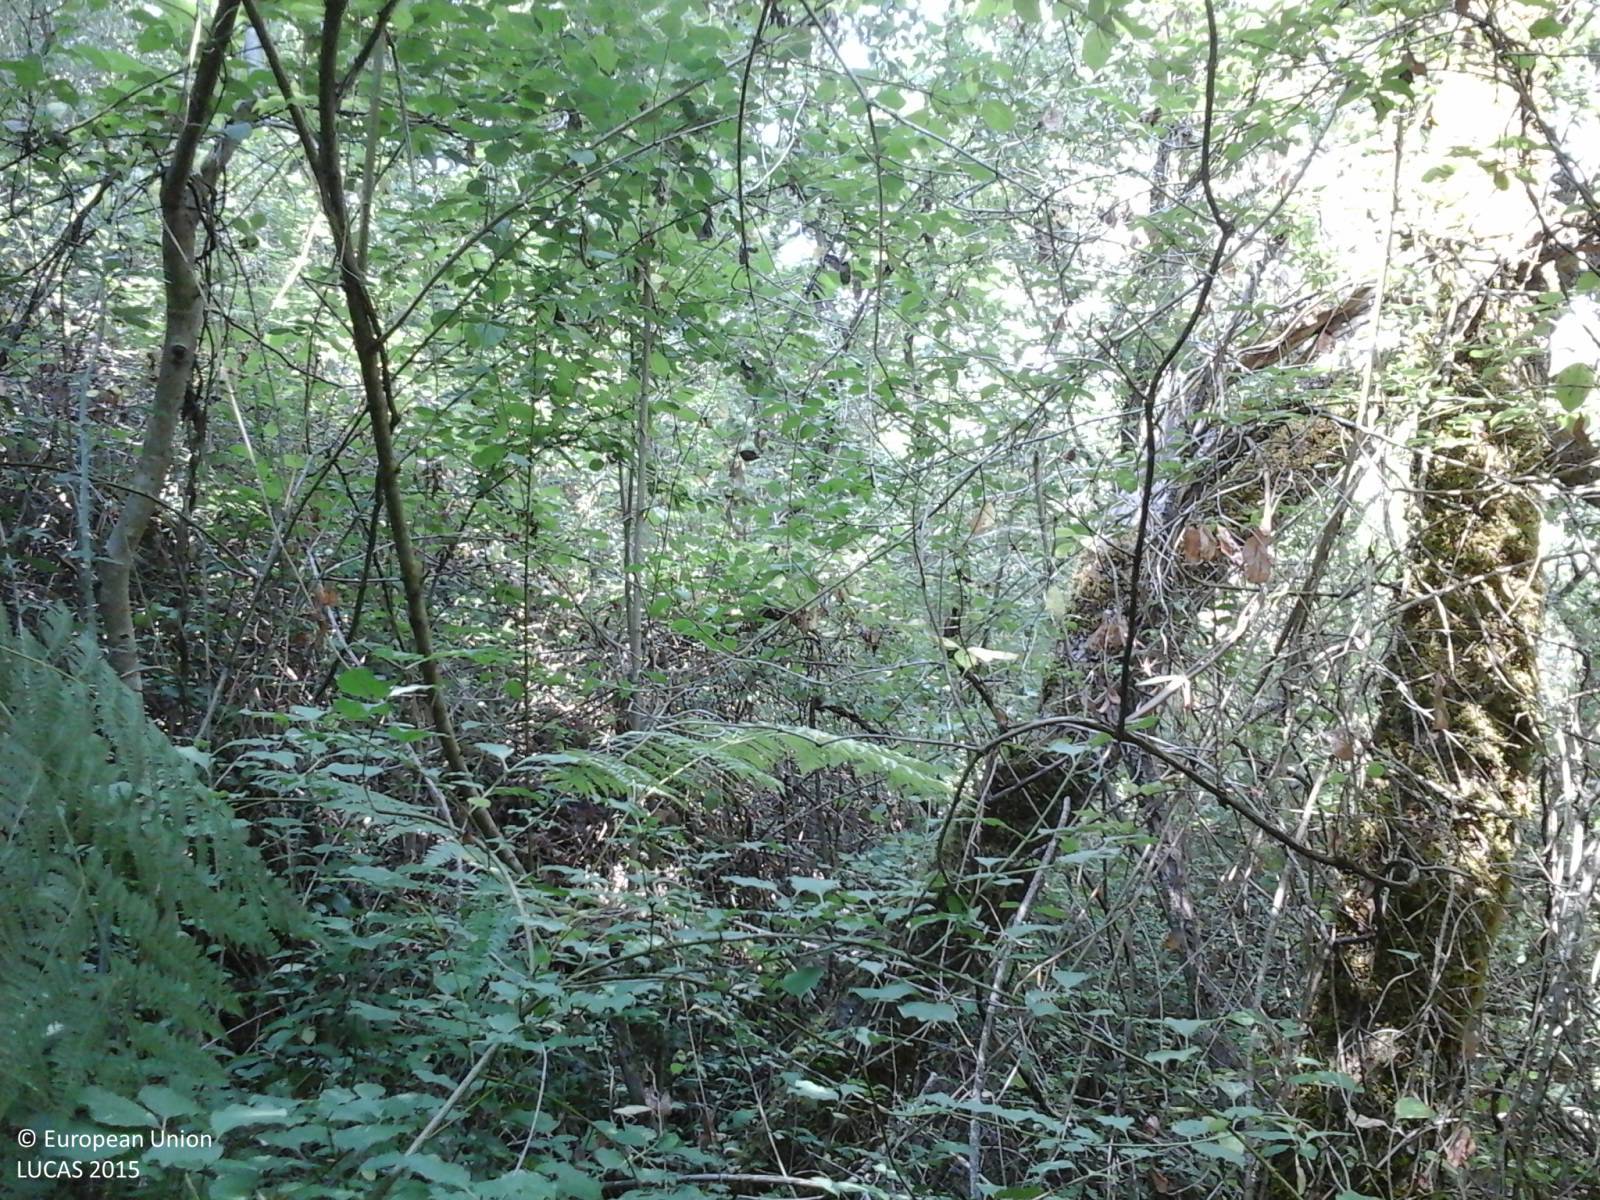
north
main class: Woodland
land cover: Broadleaved woodland
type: thermophilous deciduous forest
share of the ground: > 75 %
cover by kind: broadleaved forest trees 100 %
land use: Forestry
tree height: > 5 m
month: July
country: IT
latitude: 42.3102
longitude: 13.3254
